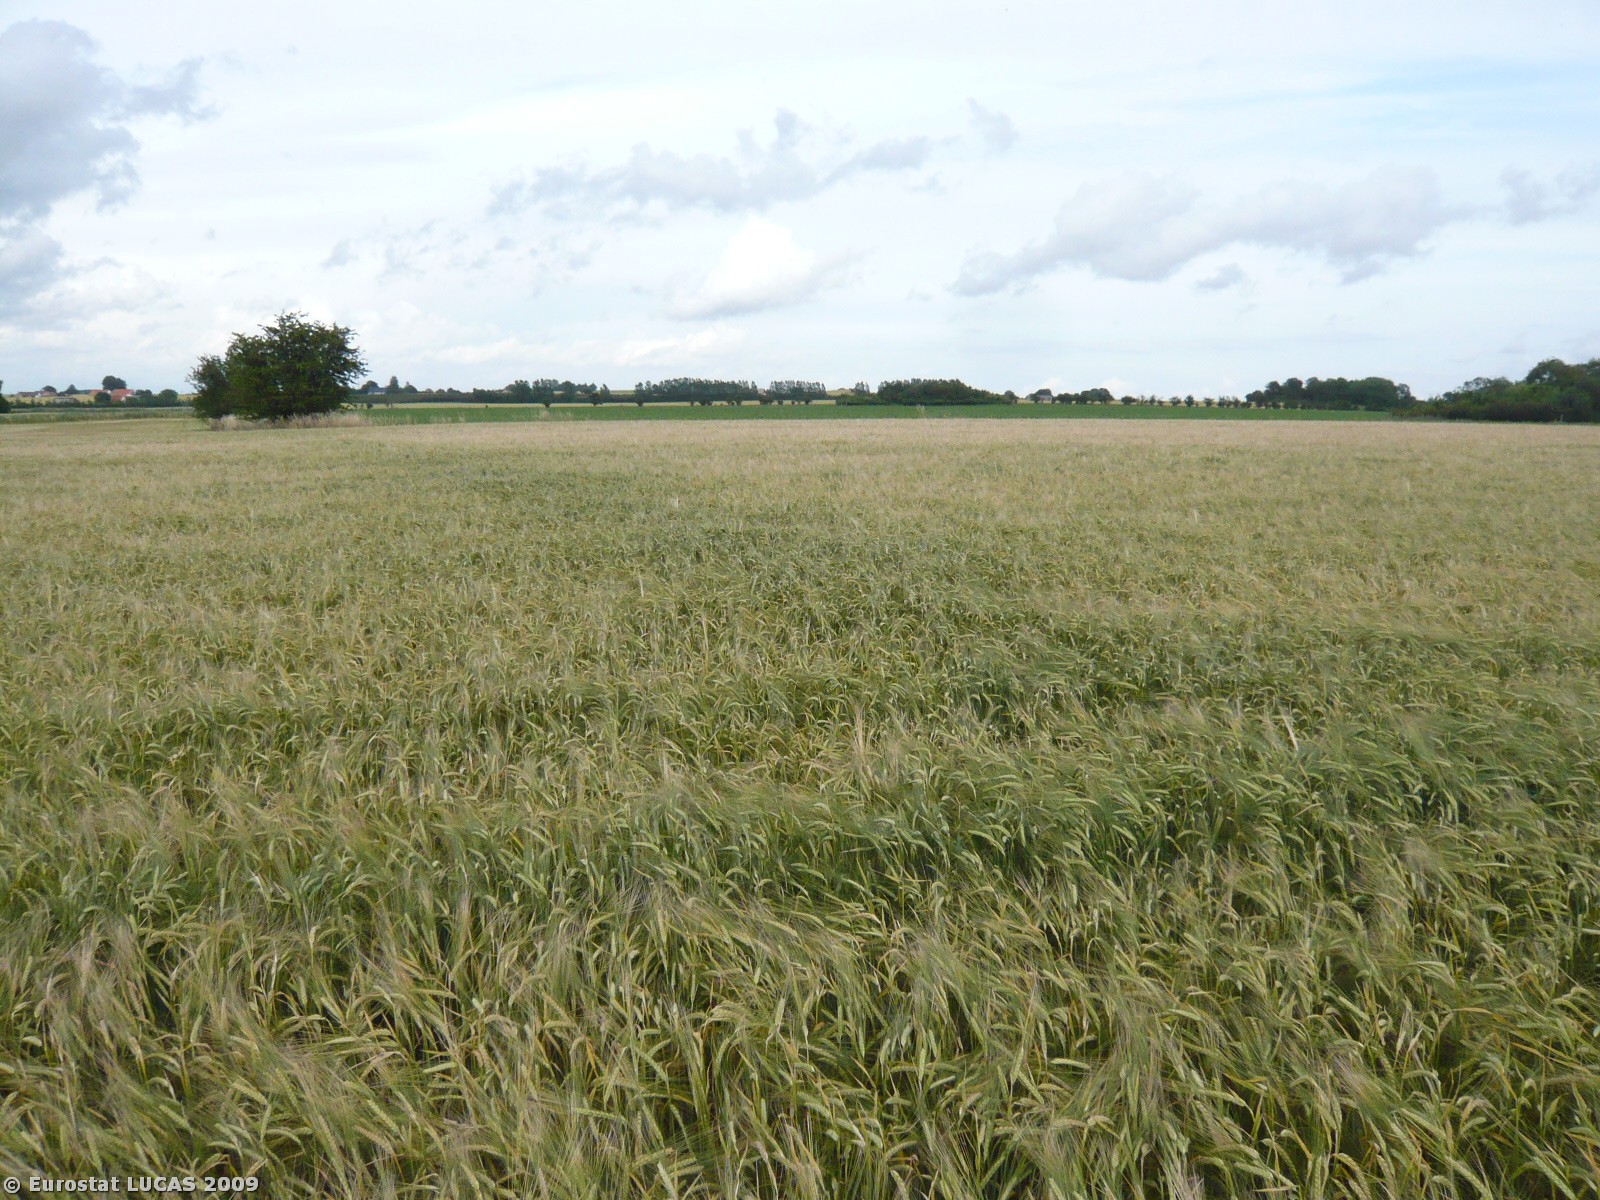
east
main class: Cropland
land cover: Barley
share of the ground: > 75 %
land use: Agriculture (excluding fallow land and kitchen gardens)
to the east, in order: Barley; Sugar beet
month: July
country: DK
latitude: 55.4449
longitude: 11.2162
